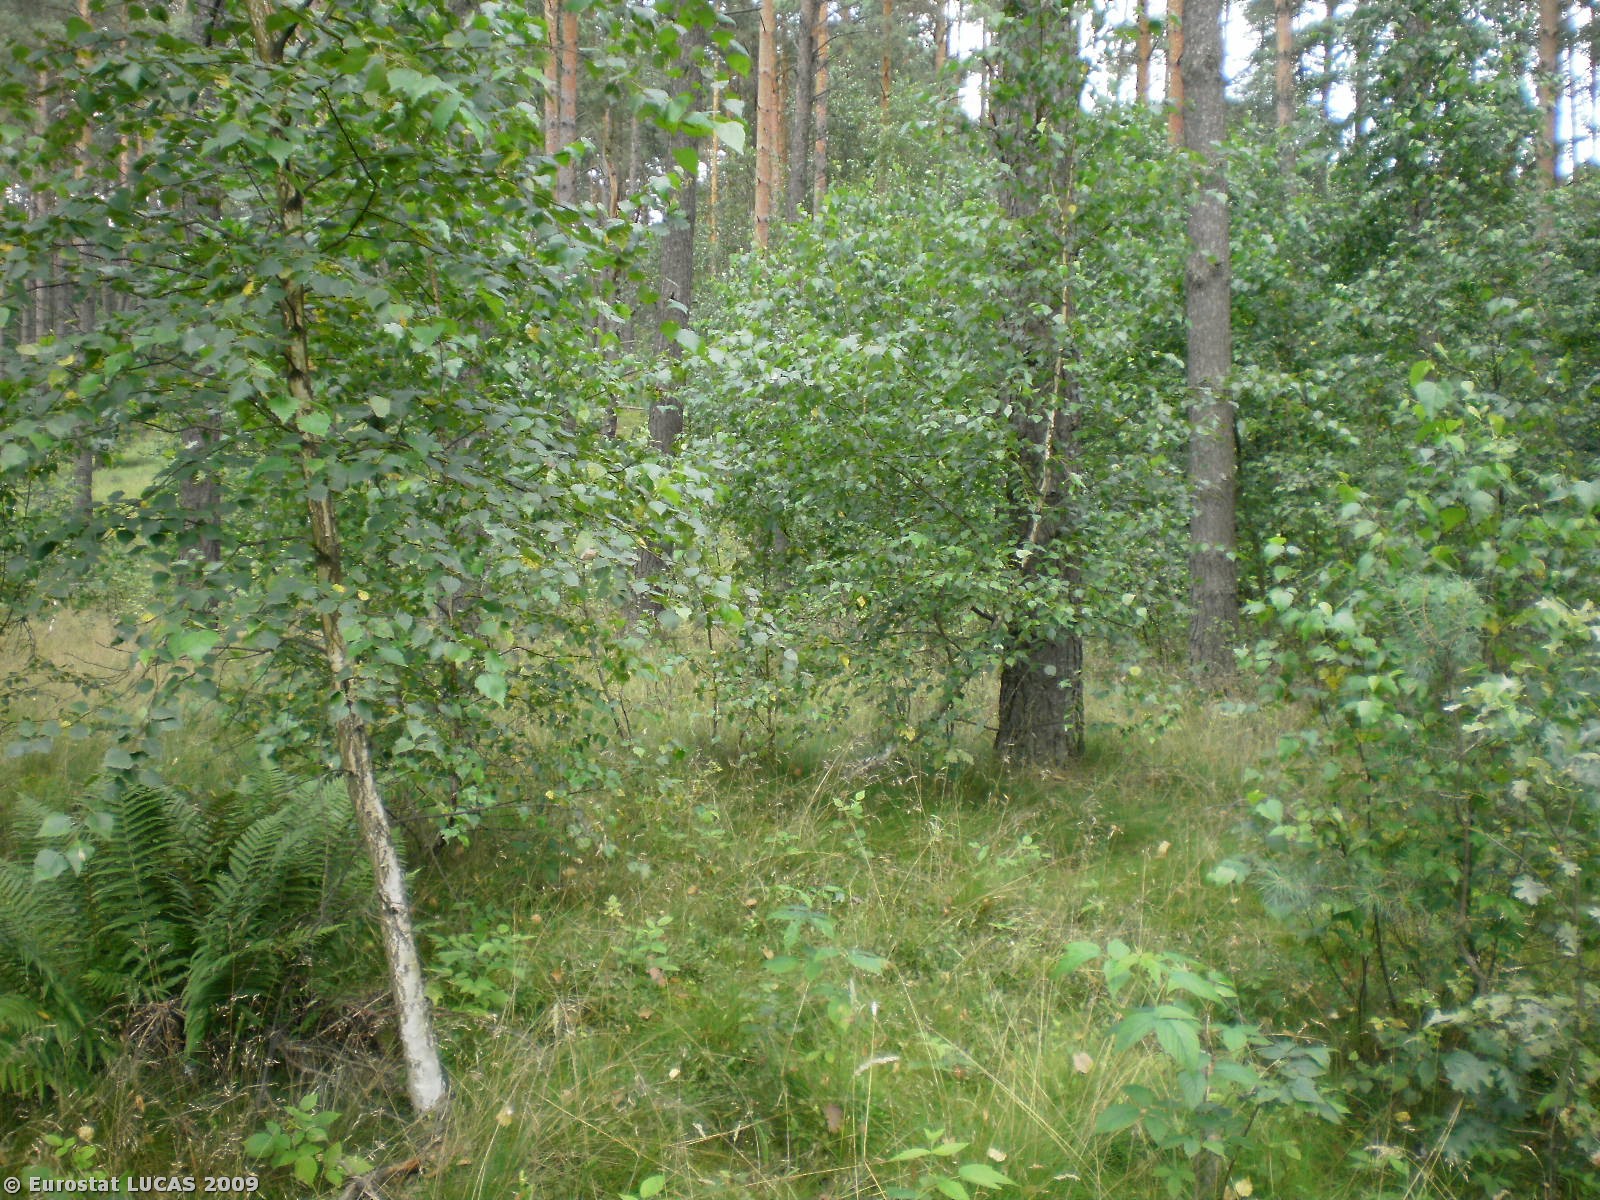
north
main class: Woodland
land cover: Coniferous woodland
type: hemiboreal forest and nemoral coniferous forest and mixed broadleaved-coniferous forest
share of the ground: > 75 %
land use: Forestry
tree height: > 5 m
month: July
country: PL
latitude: 53.4898
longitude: 20.4818
